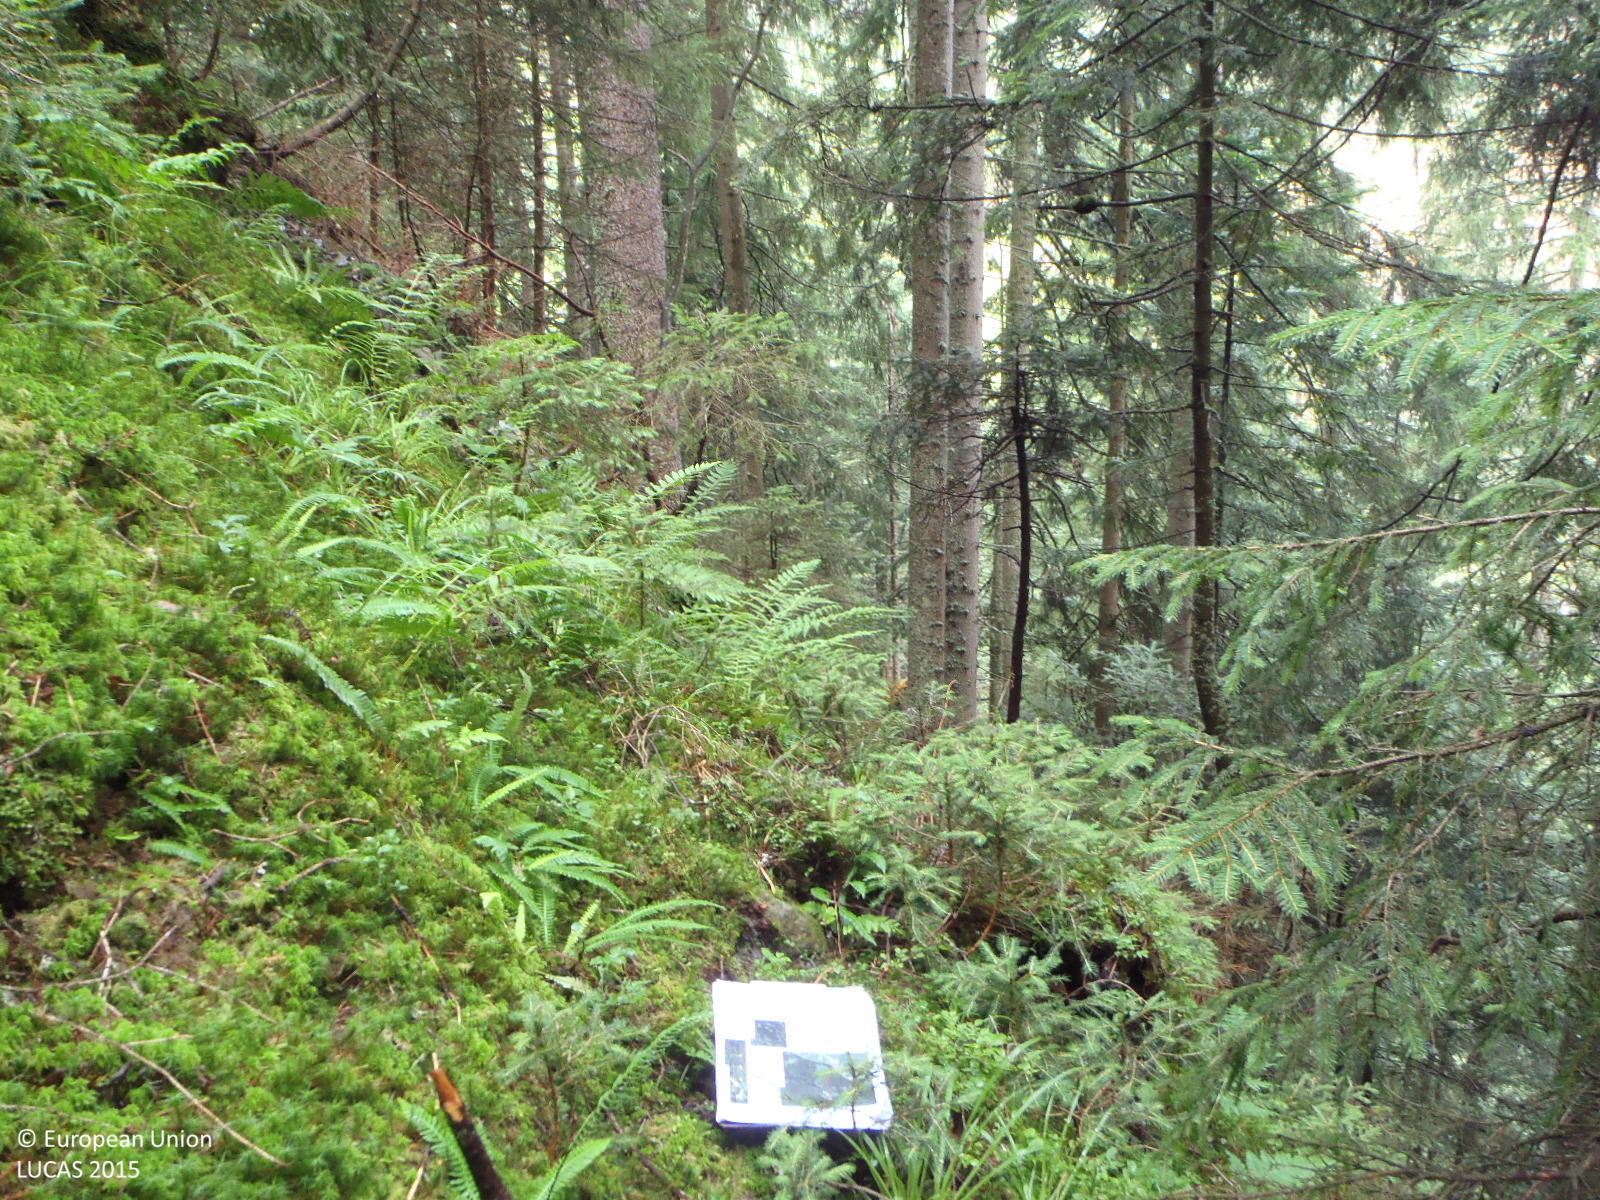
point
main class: Woodland
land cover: Spruce dominated coniferous woodland
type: alpine coniferous forest
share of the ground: > 75 %
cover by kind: coniferous forest trees 80 %, herbaceous plants 10 %, lichens and mosses 10 %
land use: Forestry
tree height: > 5 m
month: July
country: AT
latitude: 47.2901
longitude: 11.8364
